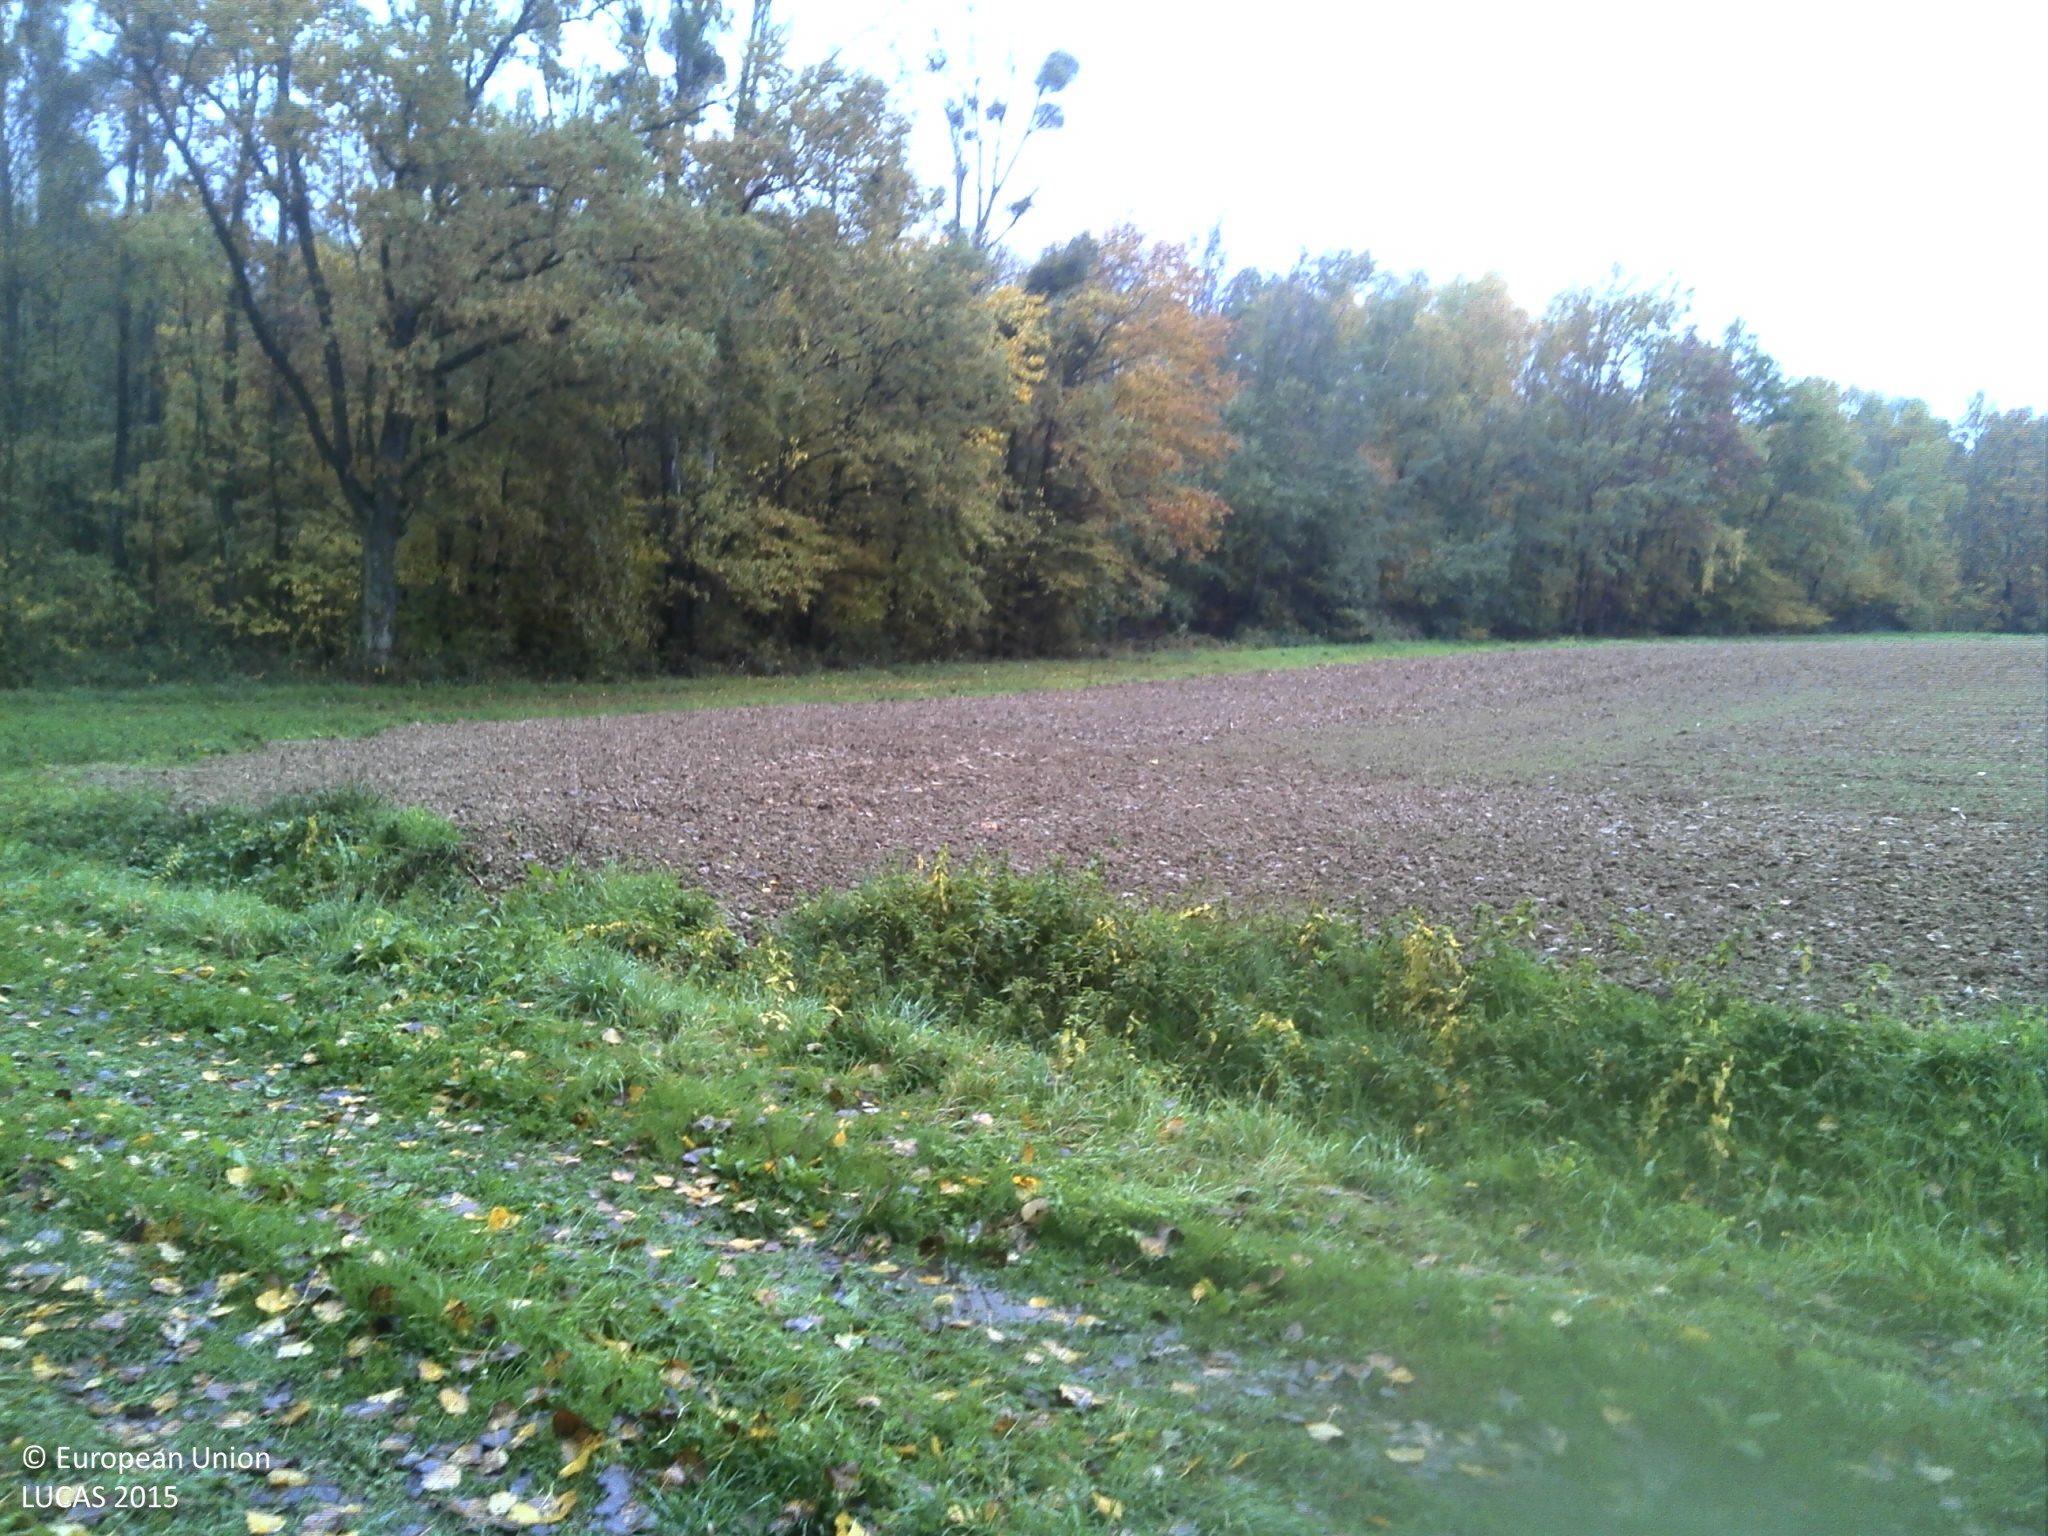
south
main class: Woodland
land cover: Broadleaved woodland
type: non-riverine alder, birch or aspen forest
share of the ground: > 75 %
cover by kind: broadleaved forest trees 100 %
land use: Forestry
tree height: > 5 m
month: October
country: FR
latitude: 47.0504
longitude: 5.0911
